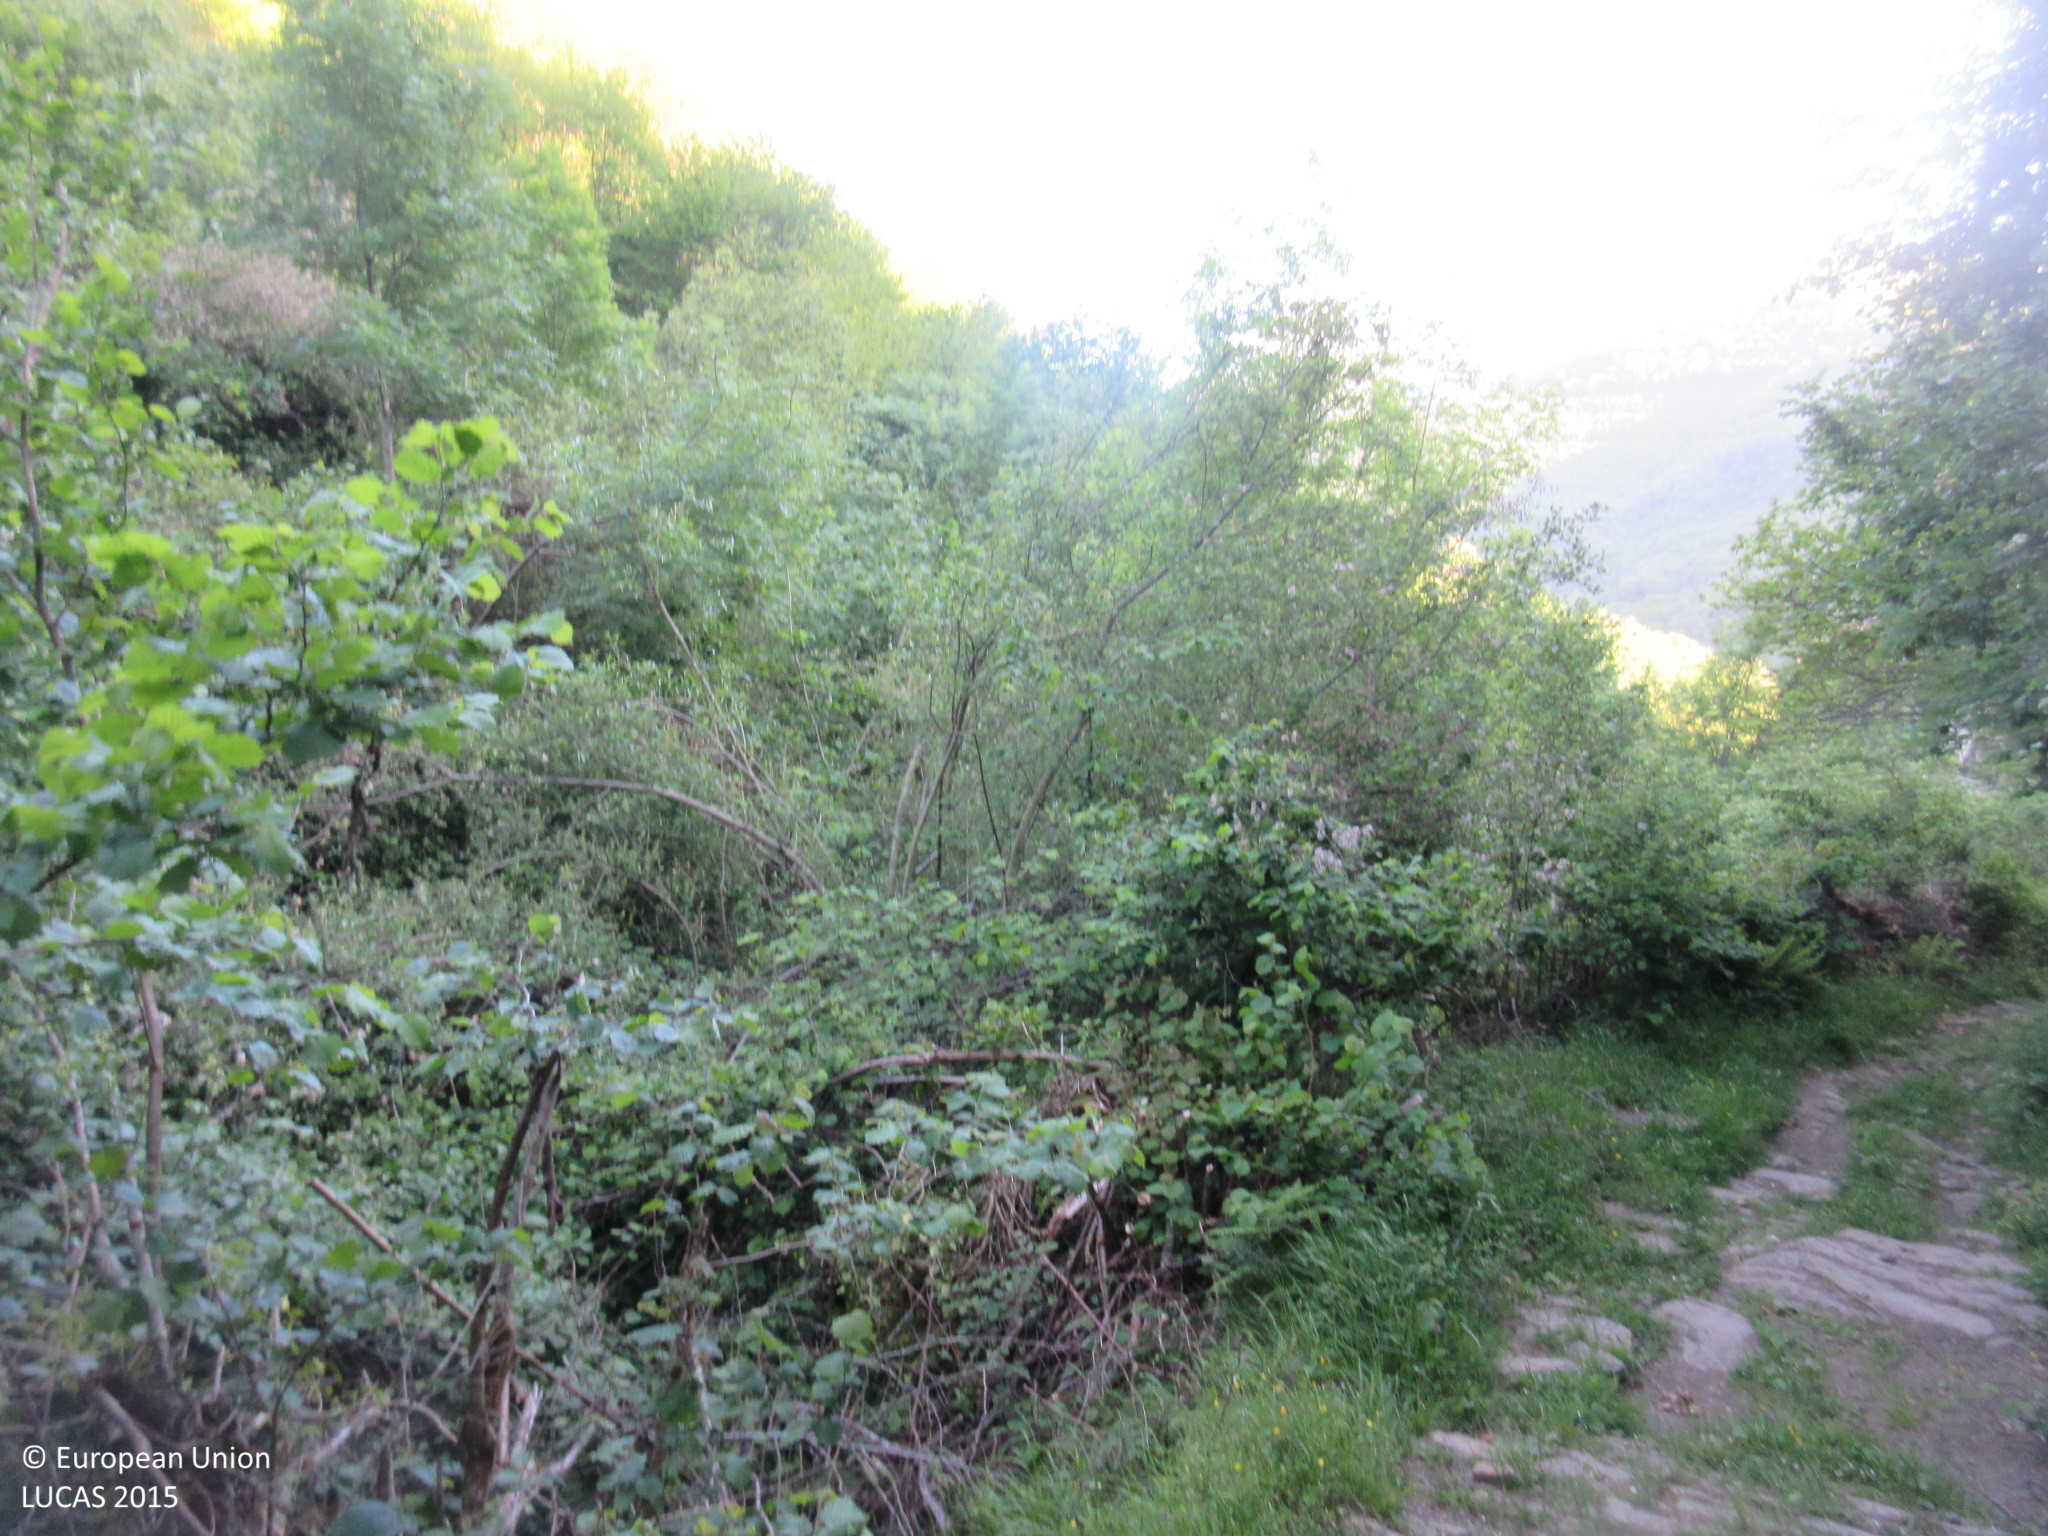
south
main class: Woodland
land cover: Broadleaved woodland
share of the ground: > 75 %
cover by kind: broadleaved forest trees 95 %, shrubs 5 %
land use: Semi-natural and natural areas not in use
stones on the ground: 25 - 50 %
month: May
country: ES
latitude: 43.1183
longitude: -5.5268
